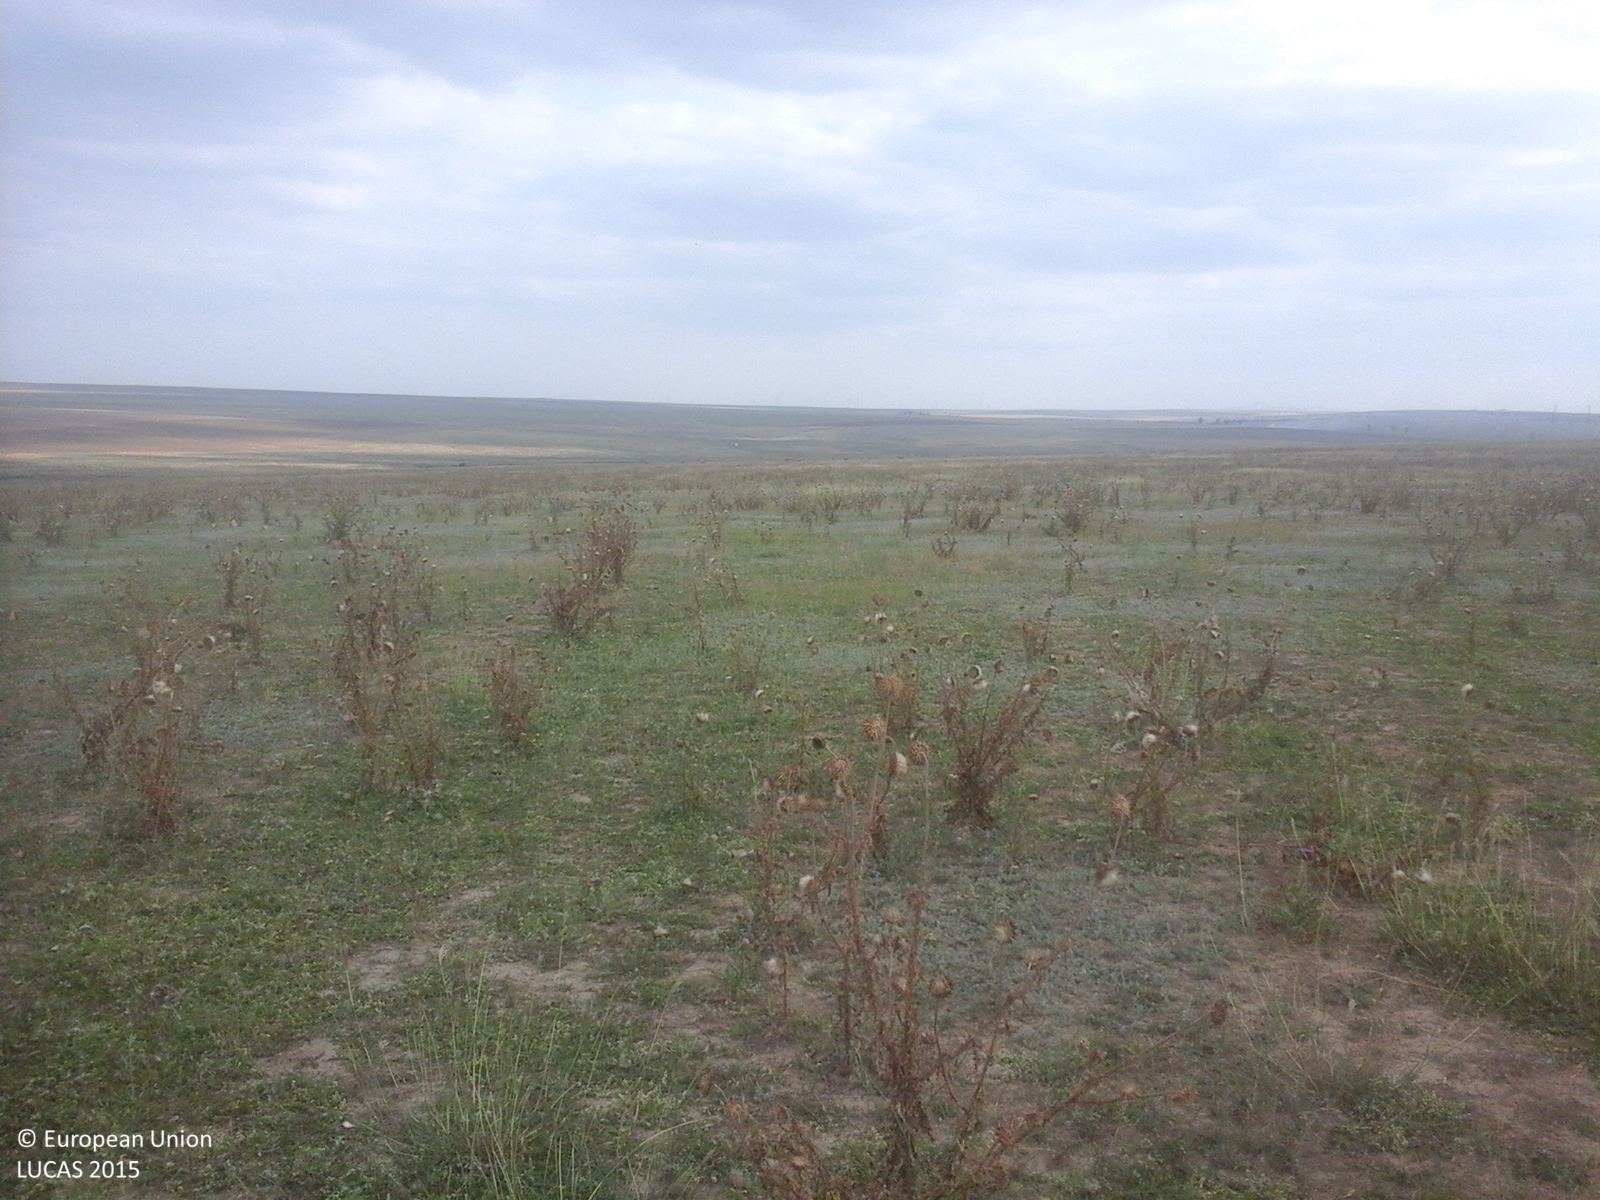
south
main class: Grassland
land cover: Spontaneously vegetated surfaces
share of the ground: > 75 %
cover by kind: herbaceous plants 100 %
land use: Fallow land
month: August
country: RO
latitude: 44.7466
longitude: 28.2423
